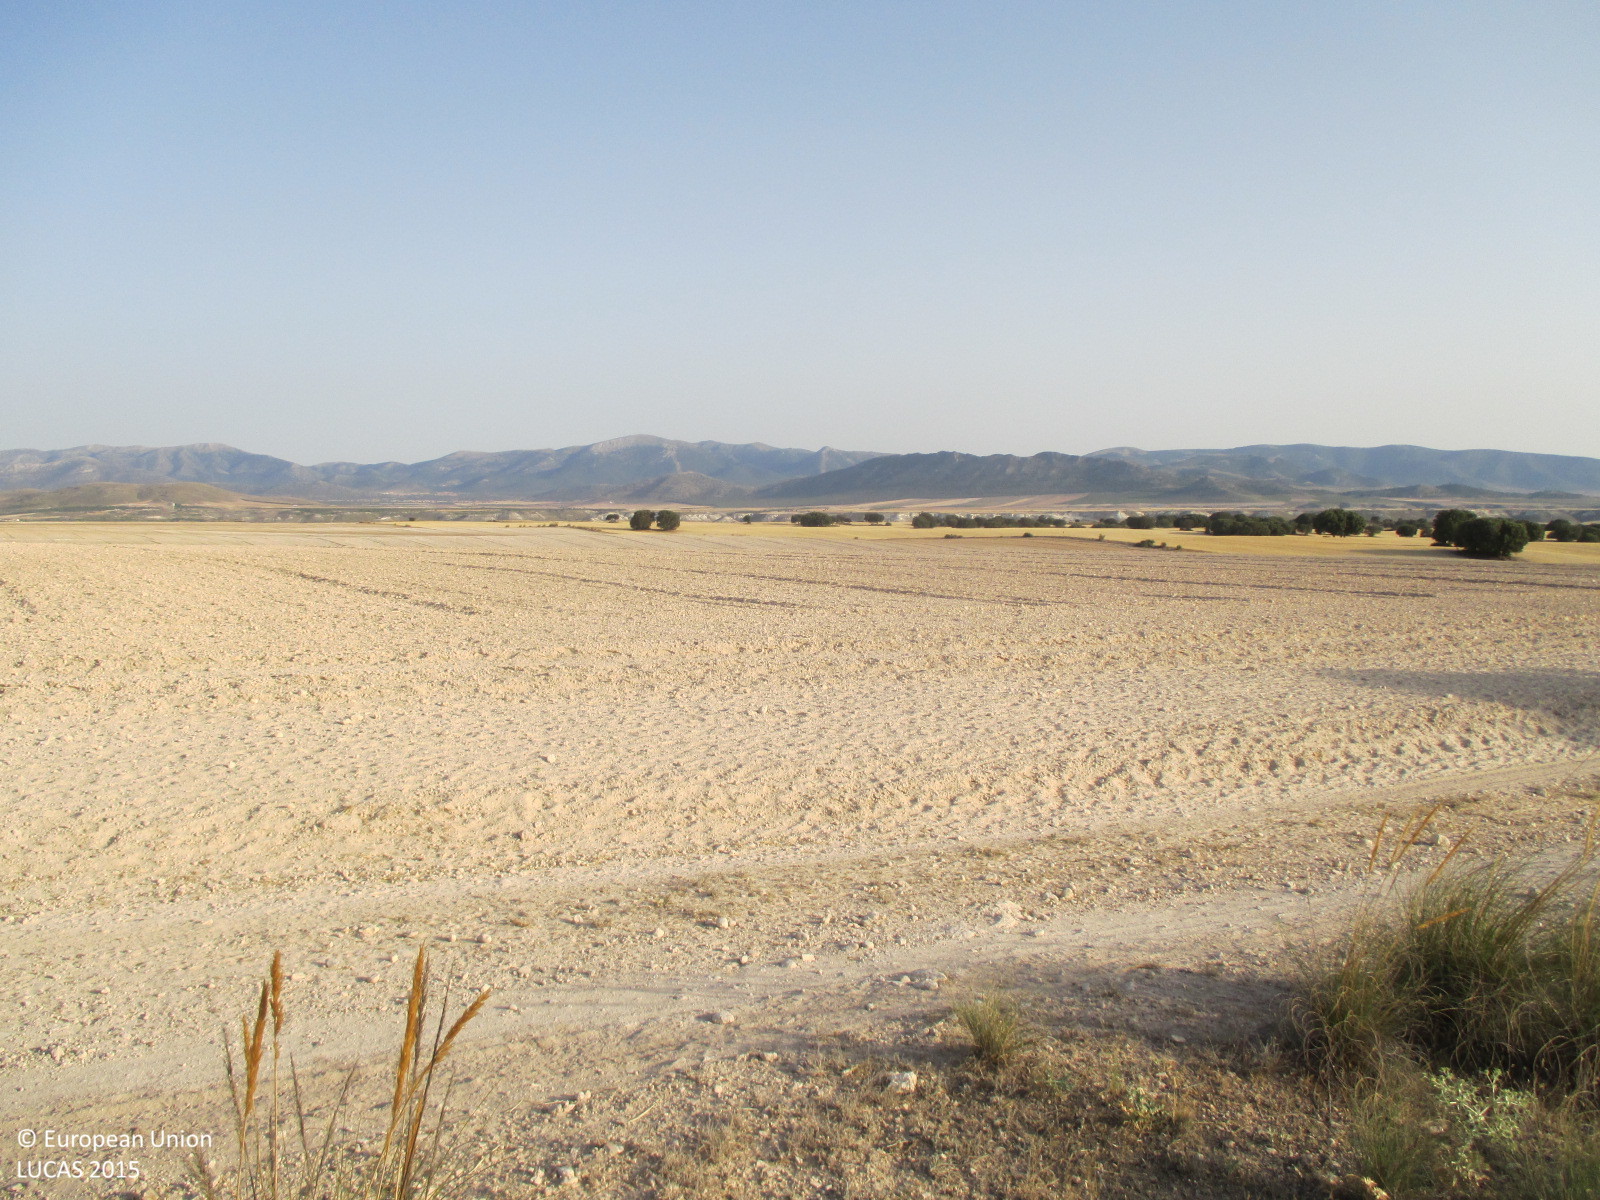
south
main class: Cropland
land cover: Oats
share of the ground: 25 - 50 %
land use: Agriculture (excluding fallow land and kitchen gardens)
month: June
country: ES
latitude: 37.7728
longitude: -2.4200
